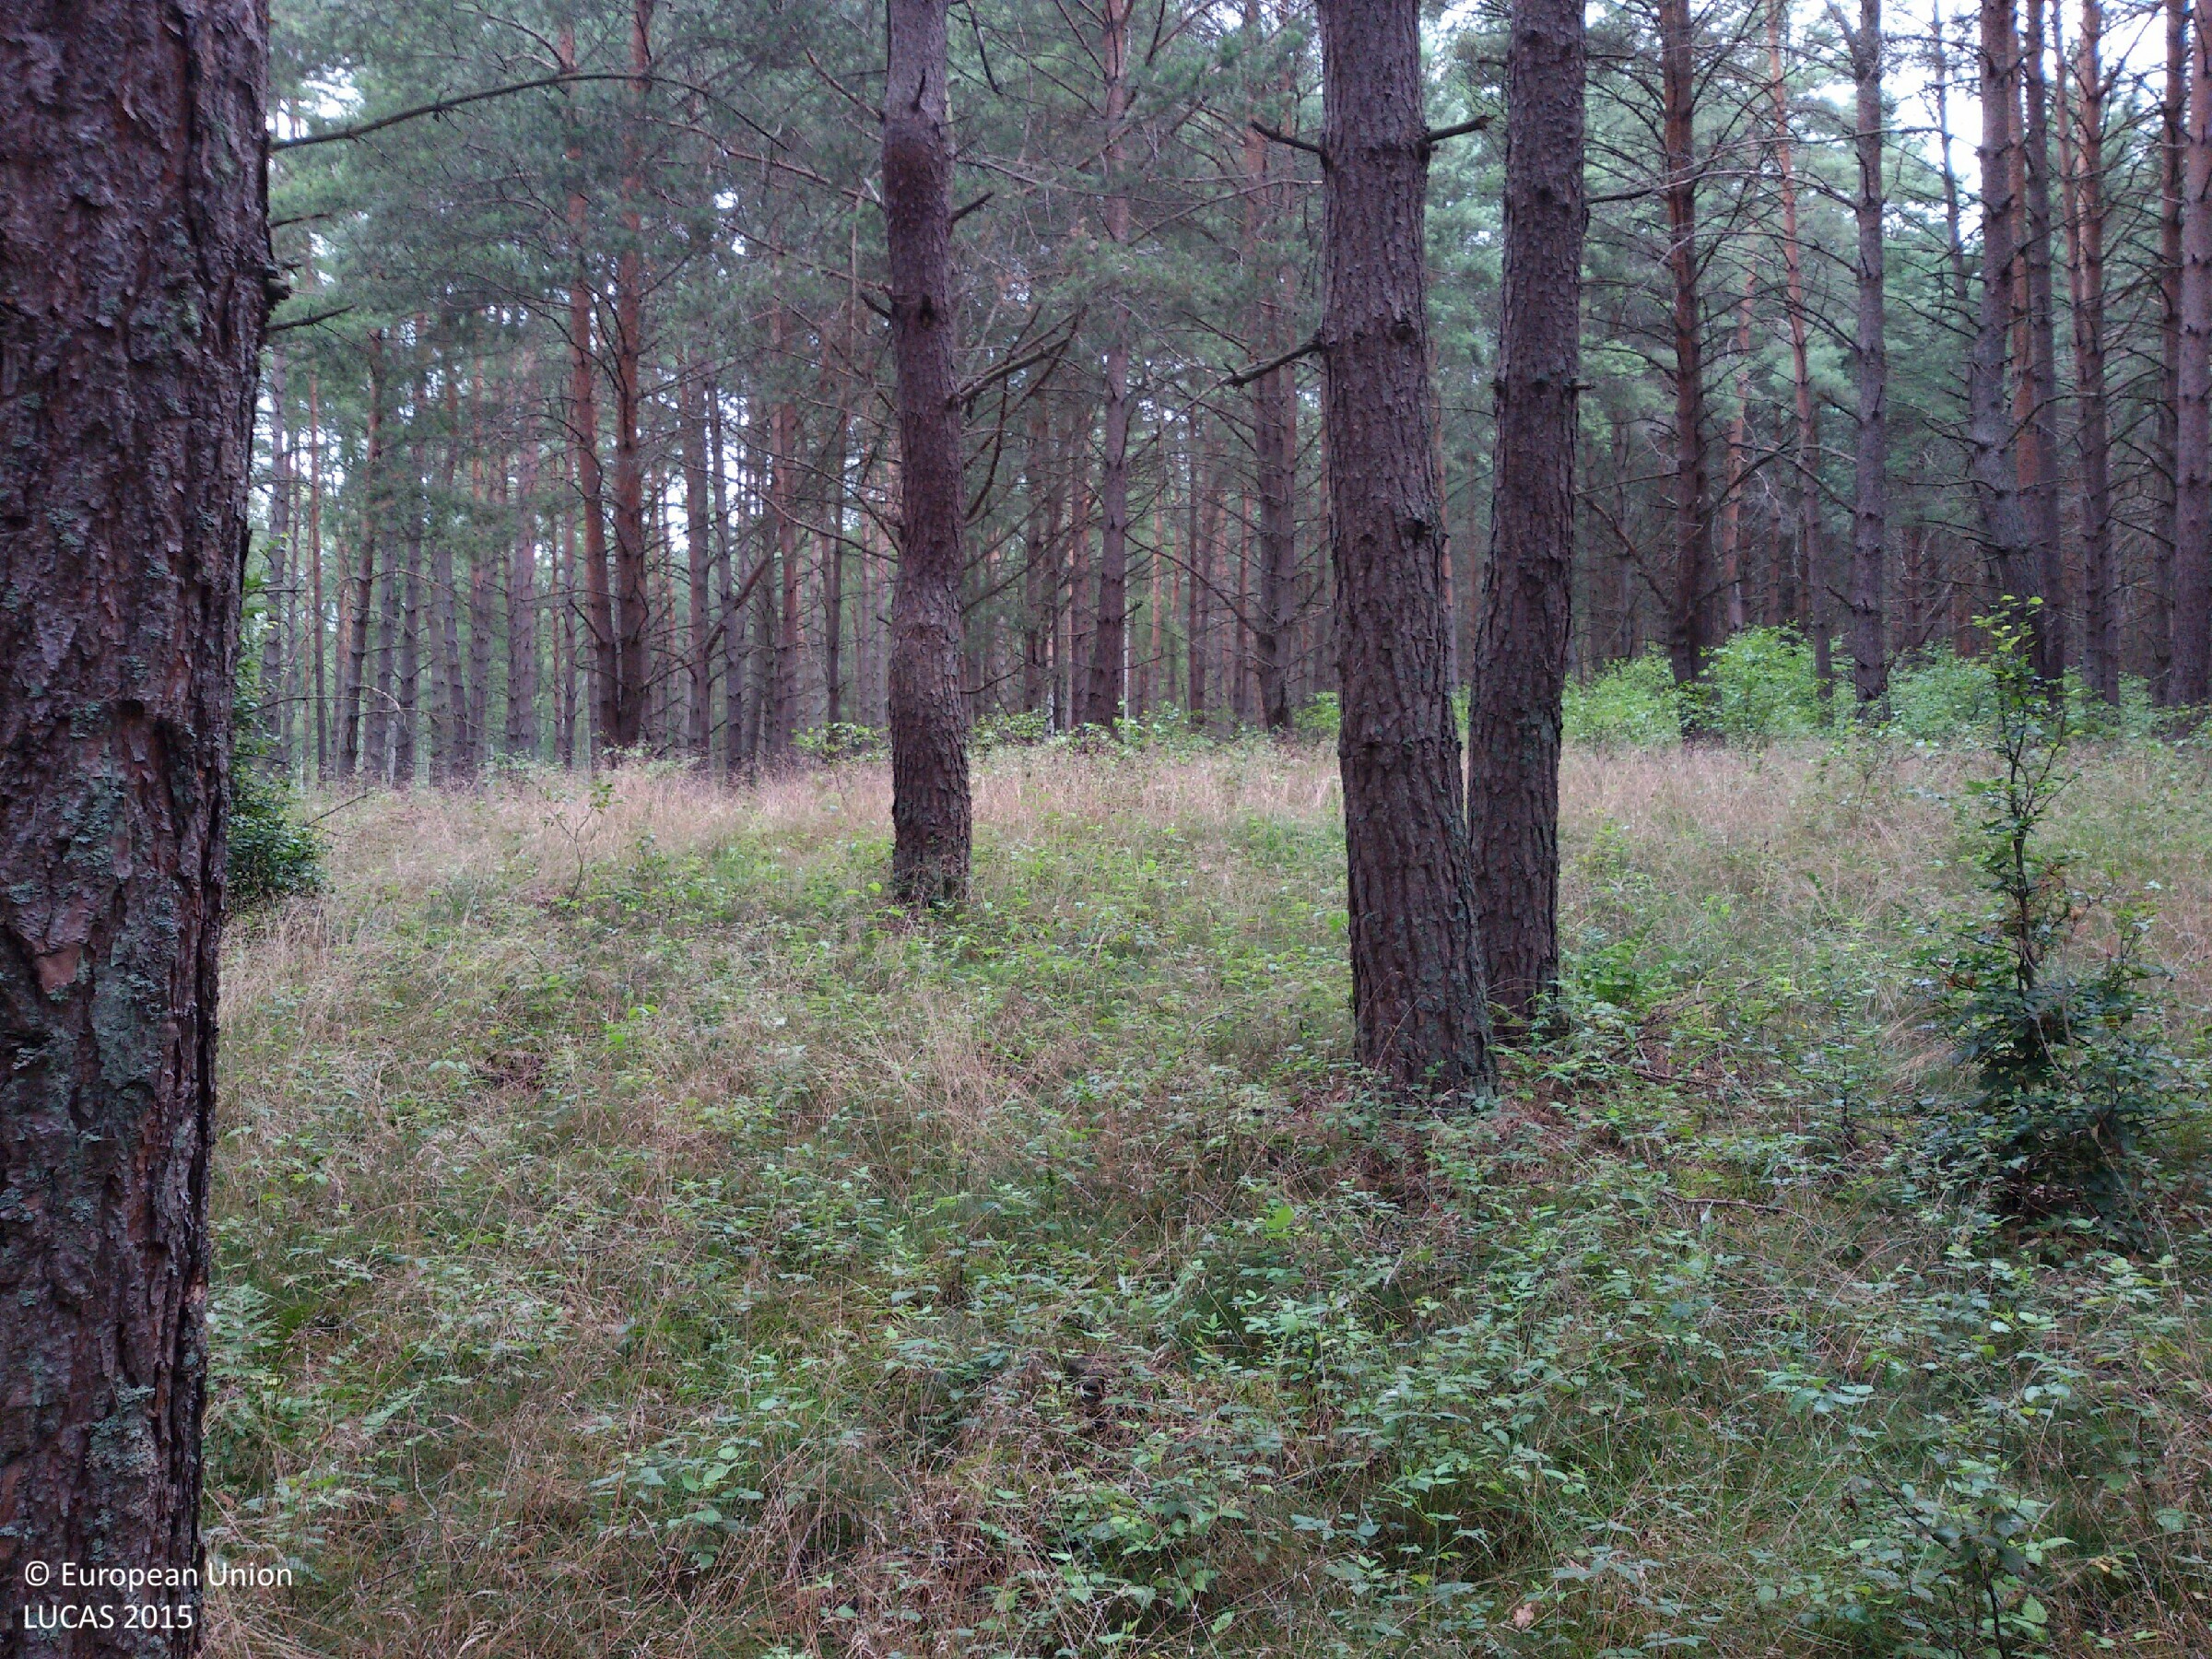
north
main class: Woodland
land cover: Pine dominated coniferous woodland
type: hemiboreal forest and nemoral coniferous forest and mixed broadleaved-coniferous forest
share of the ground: > 75 %
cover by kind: coniferous forest trees 80 %, herbaceous plants 20 %
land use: Forestry
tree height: > 5 m
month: July
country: PL
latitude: 53.2137
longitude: 16.0701
